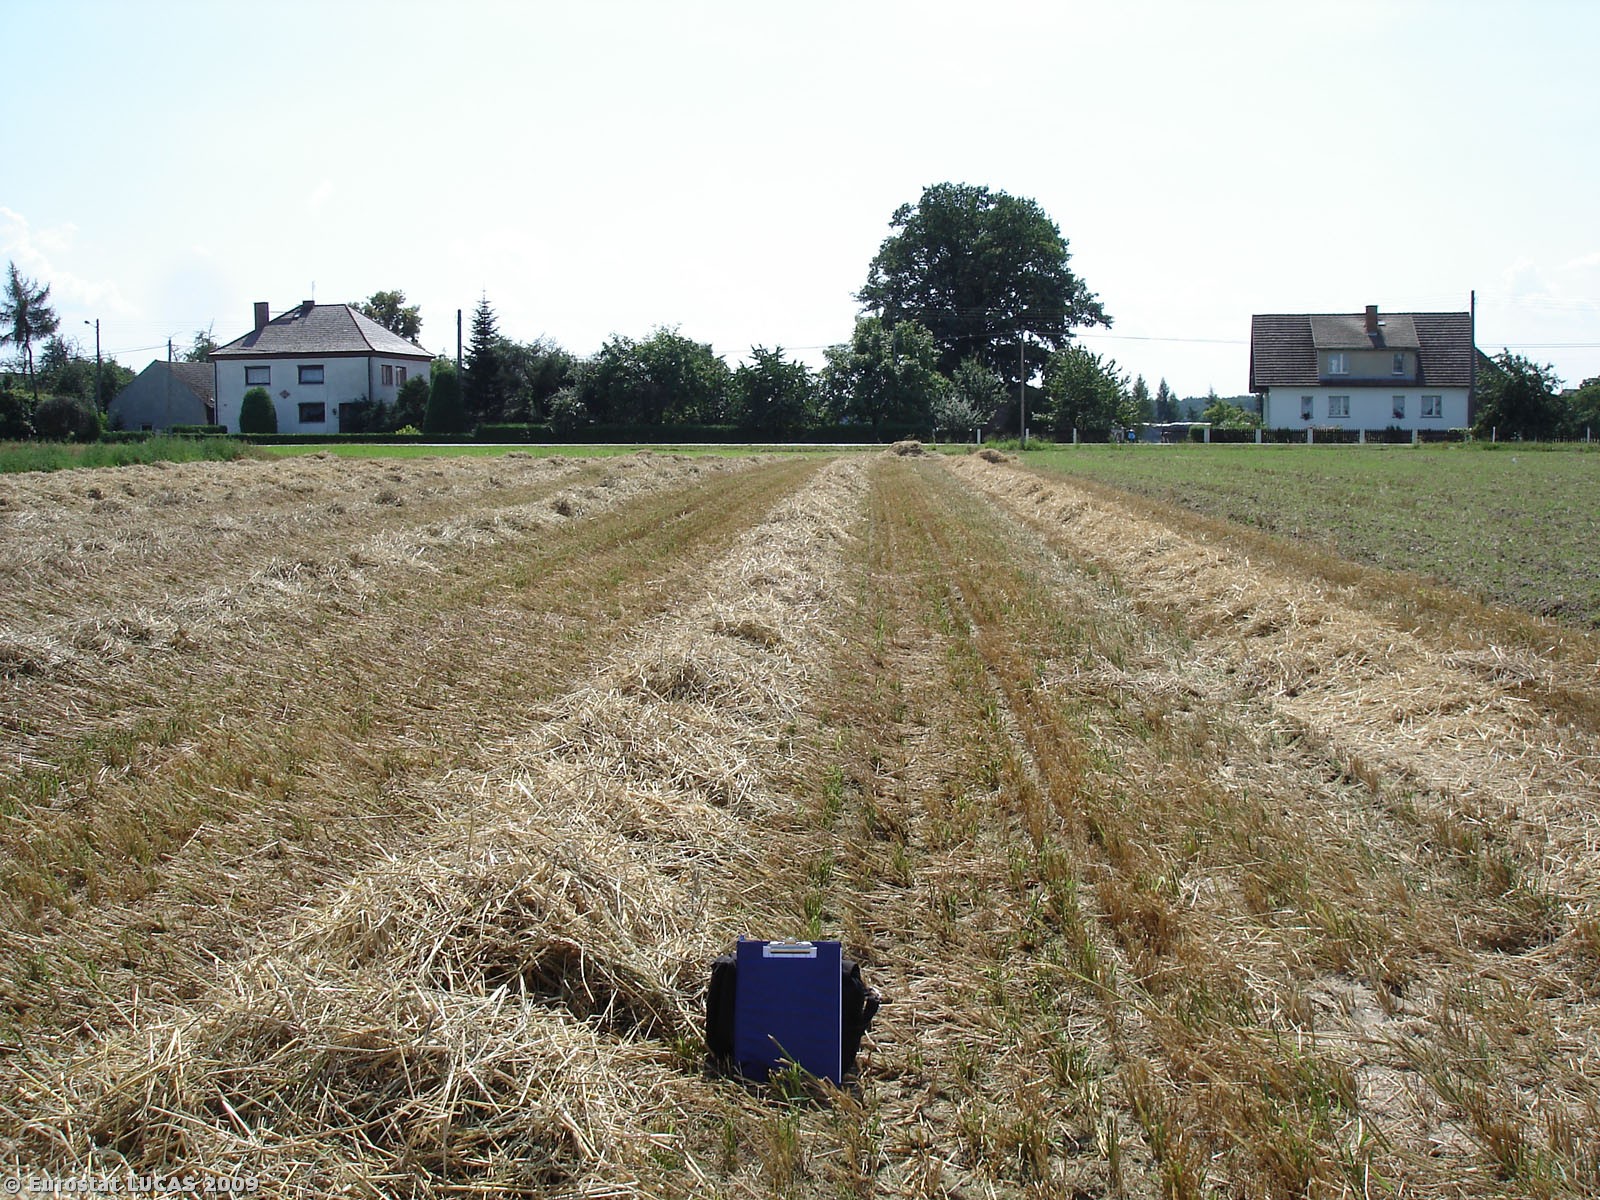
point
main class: Cropland
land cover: Mixed cereals for fodder
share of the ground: < 10 %
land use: Agriculture (excluding fallow land and kitchen gardens)
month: August
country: PL
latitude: 50.8712
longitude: 18.3598
